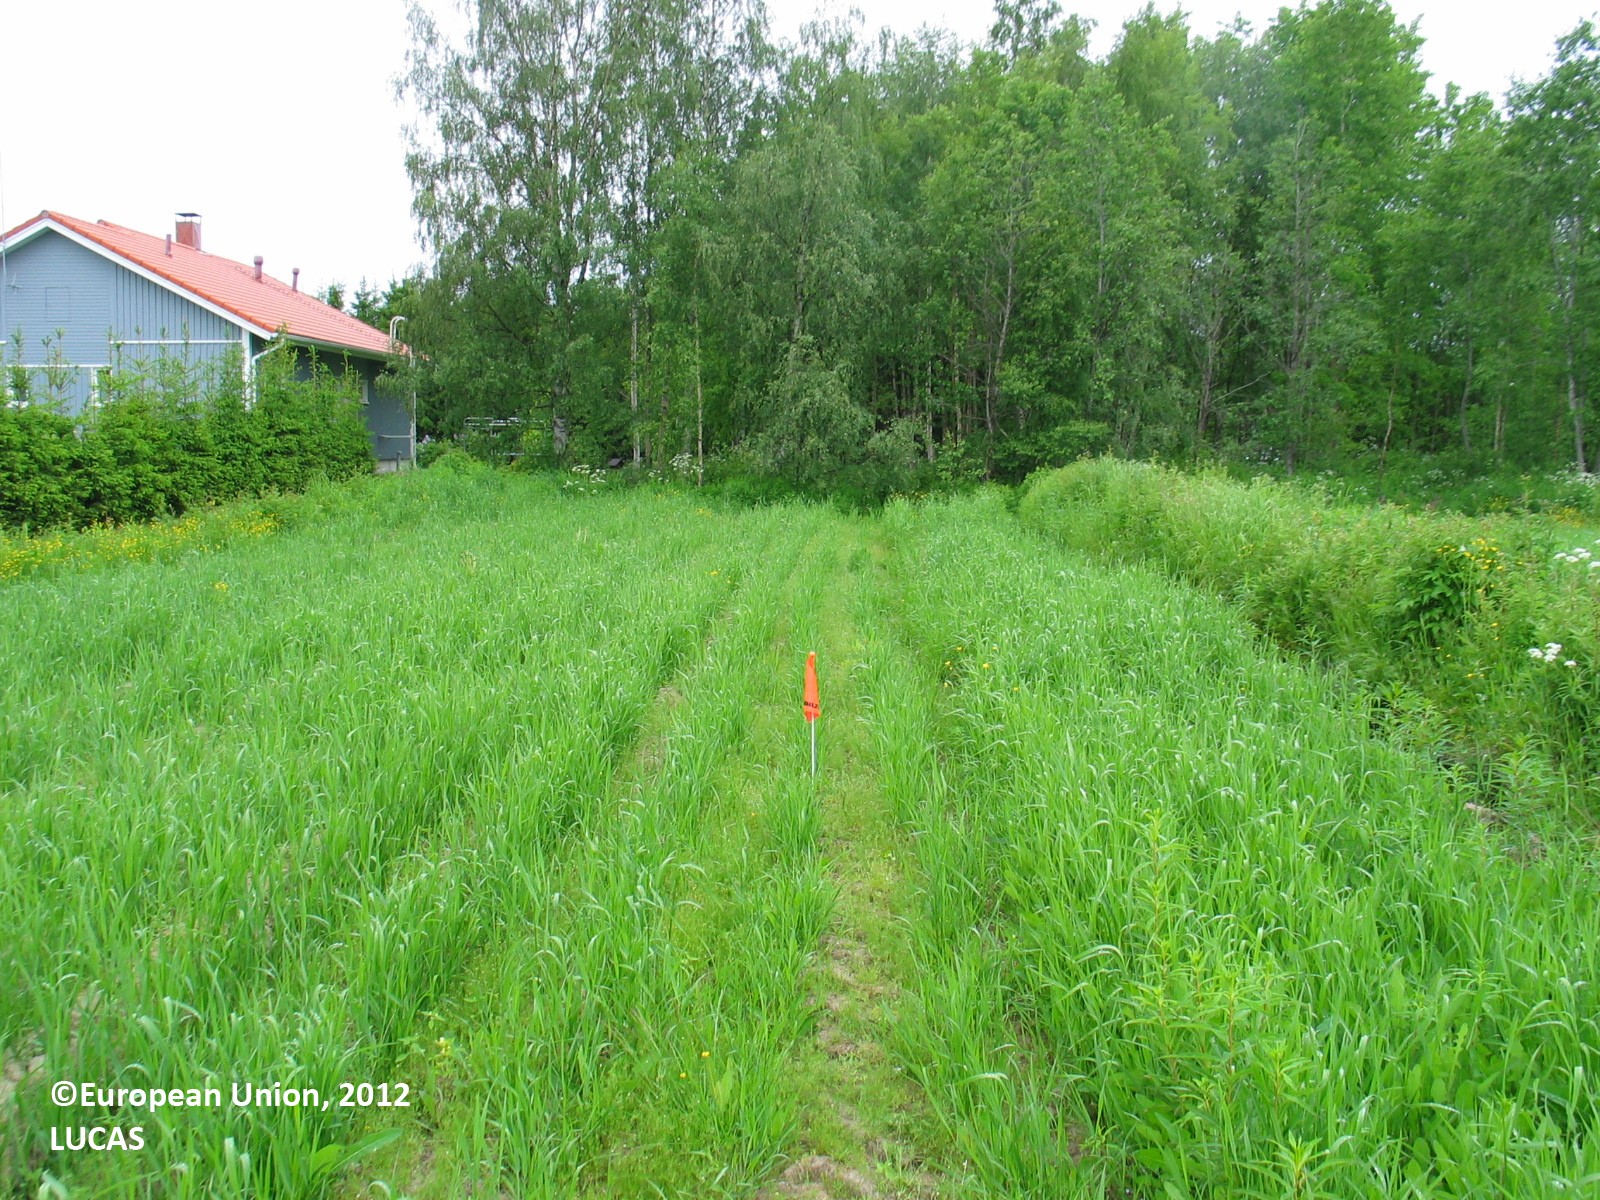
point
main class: Grassland
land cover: Grassland without tree/shrub cover
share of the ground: 25 - 50 %
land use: Agriculture (excluding fallow land and kitchen gardens)
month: June
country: FI
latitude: 65.1233
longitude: 25.3547
